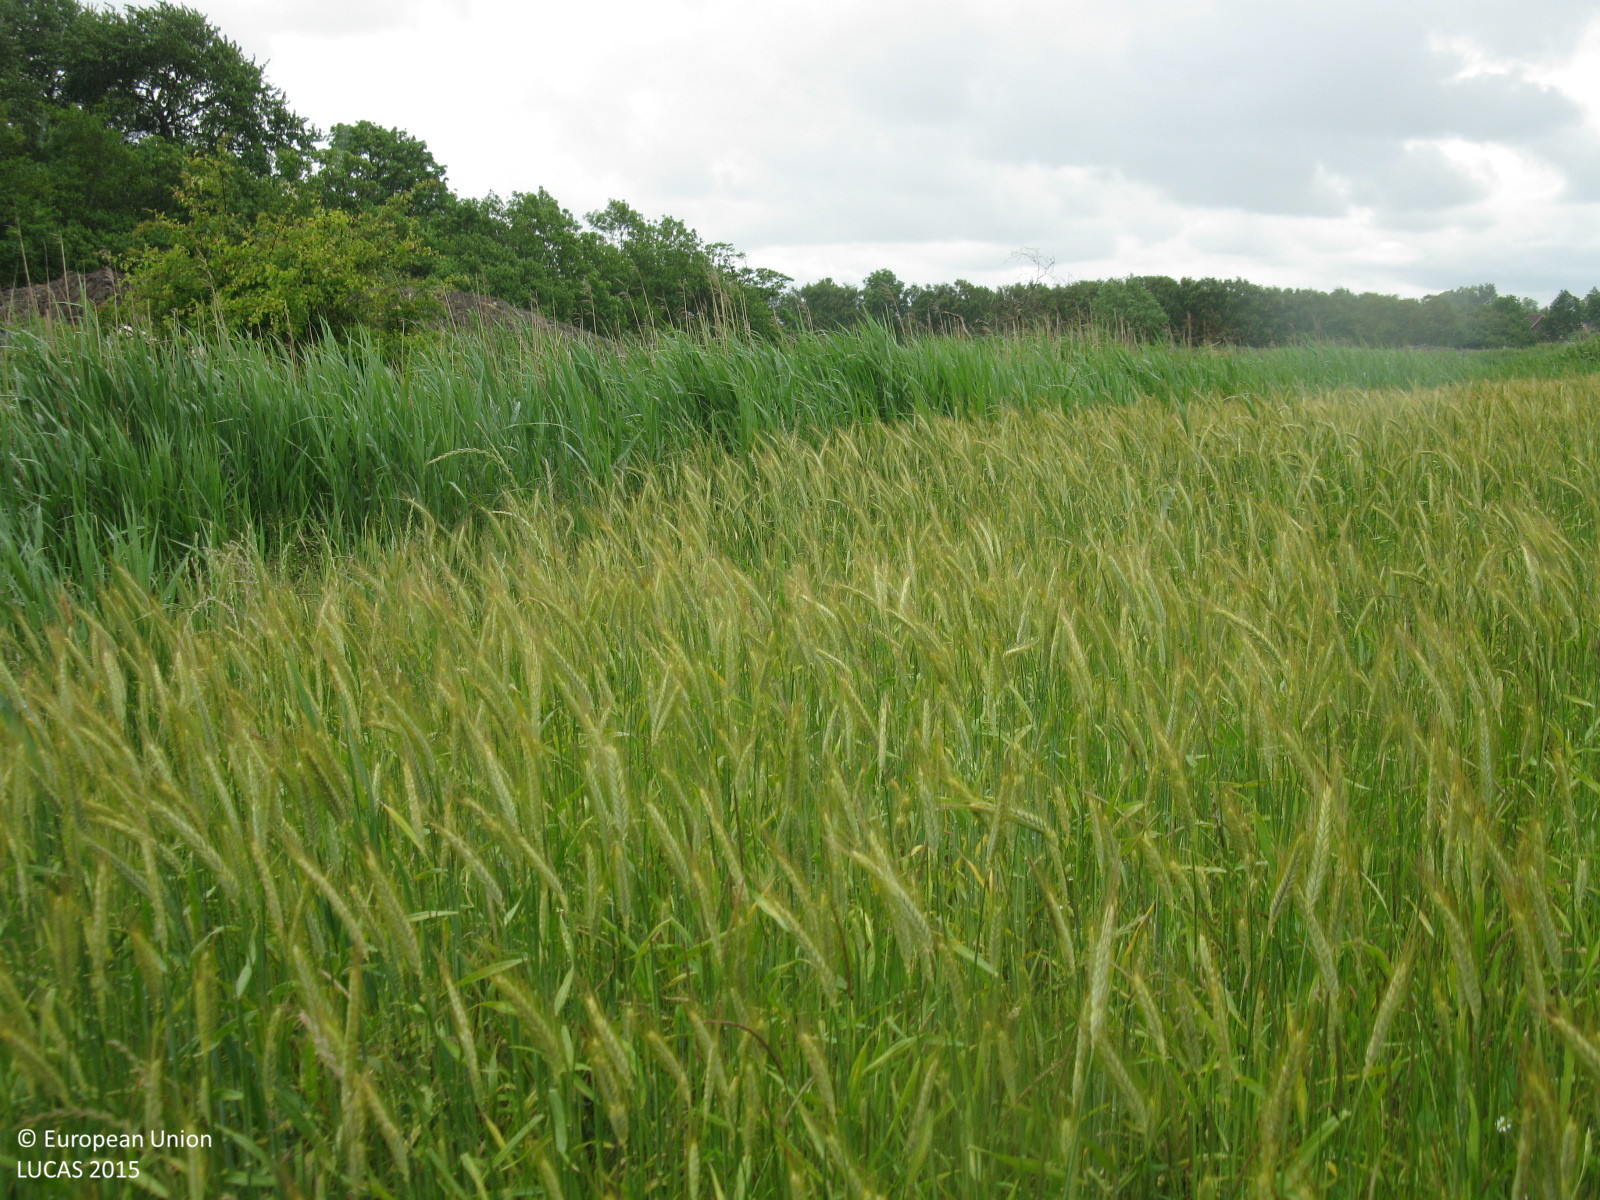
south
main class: Cropland
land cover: Triticale
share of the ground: > 75 %
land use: Agriculture (excluding fallow land and kitchen gardens)
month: June
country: DE
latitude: 53.6724
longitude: 7.9573
